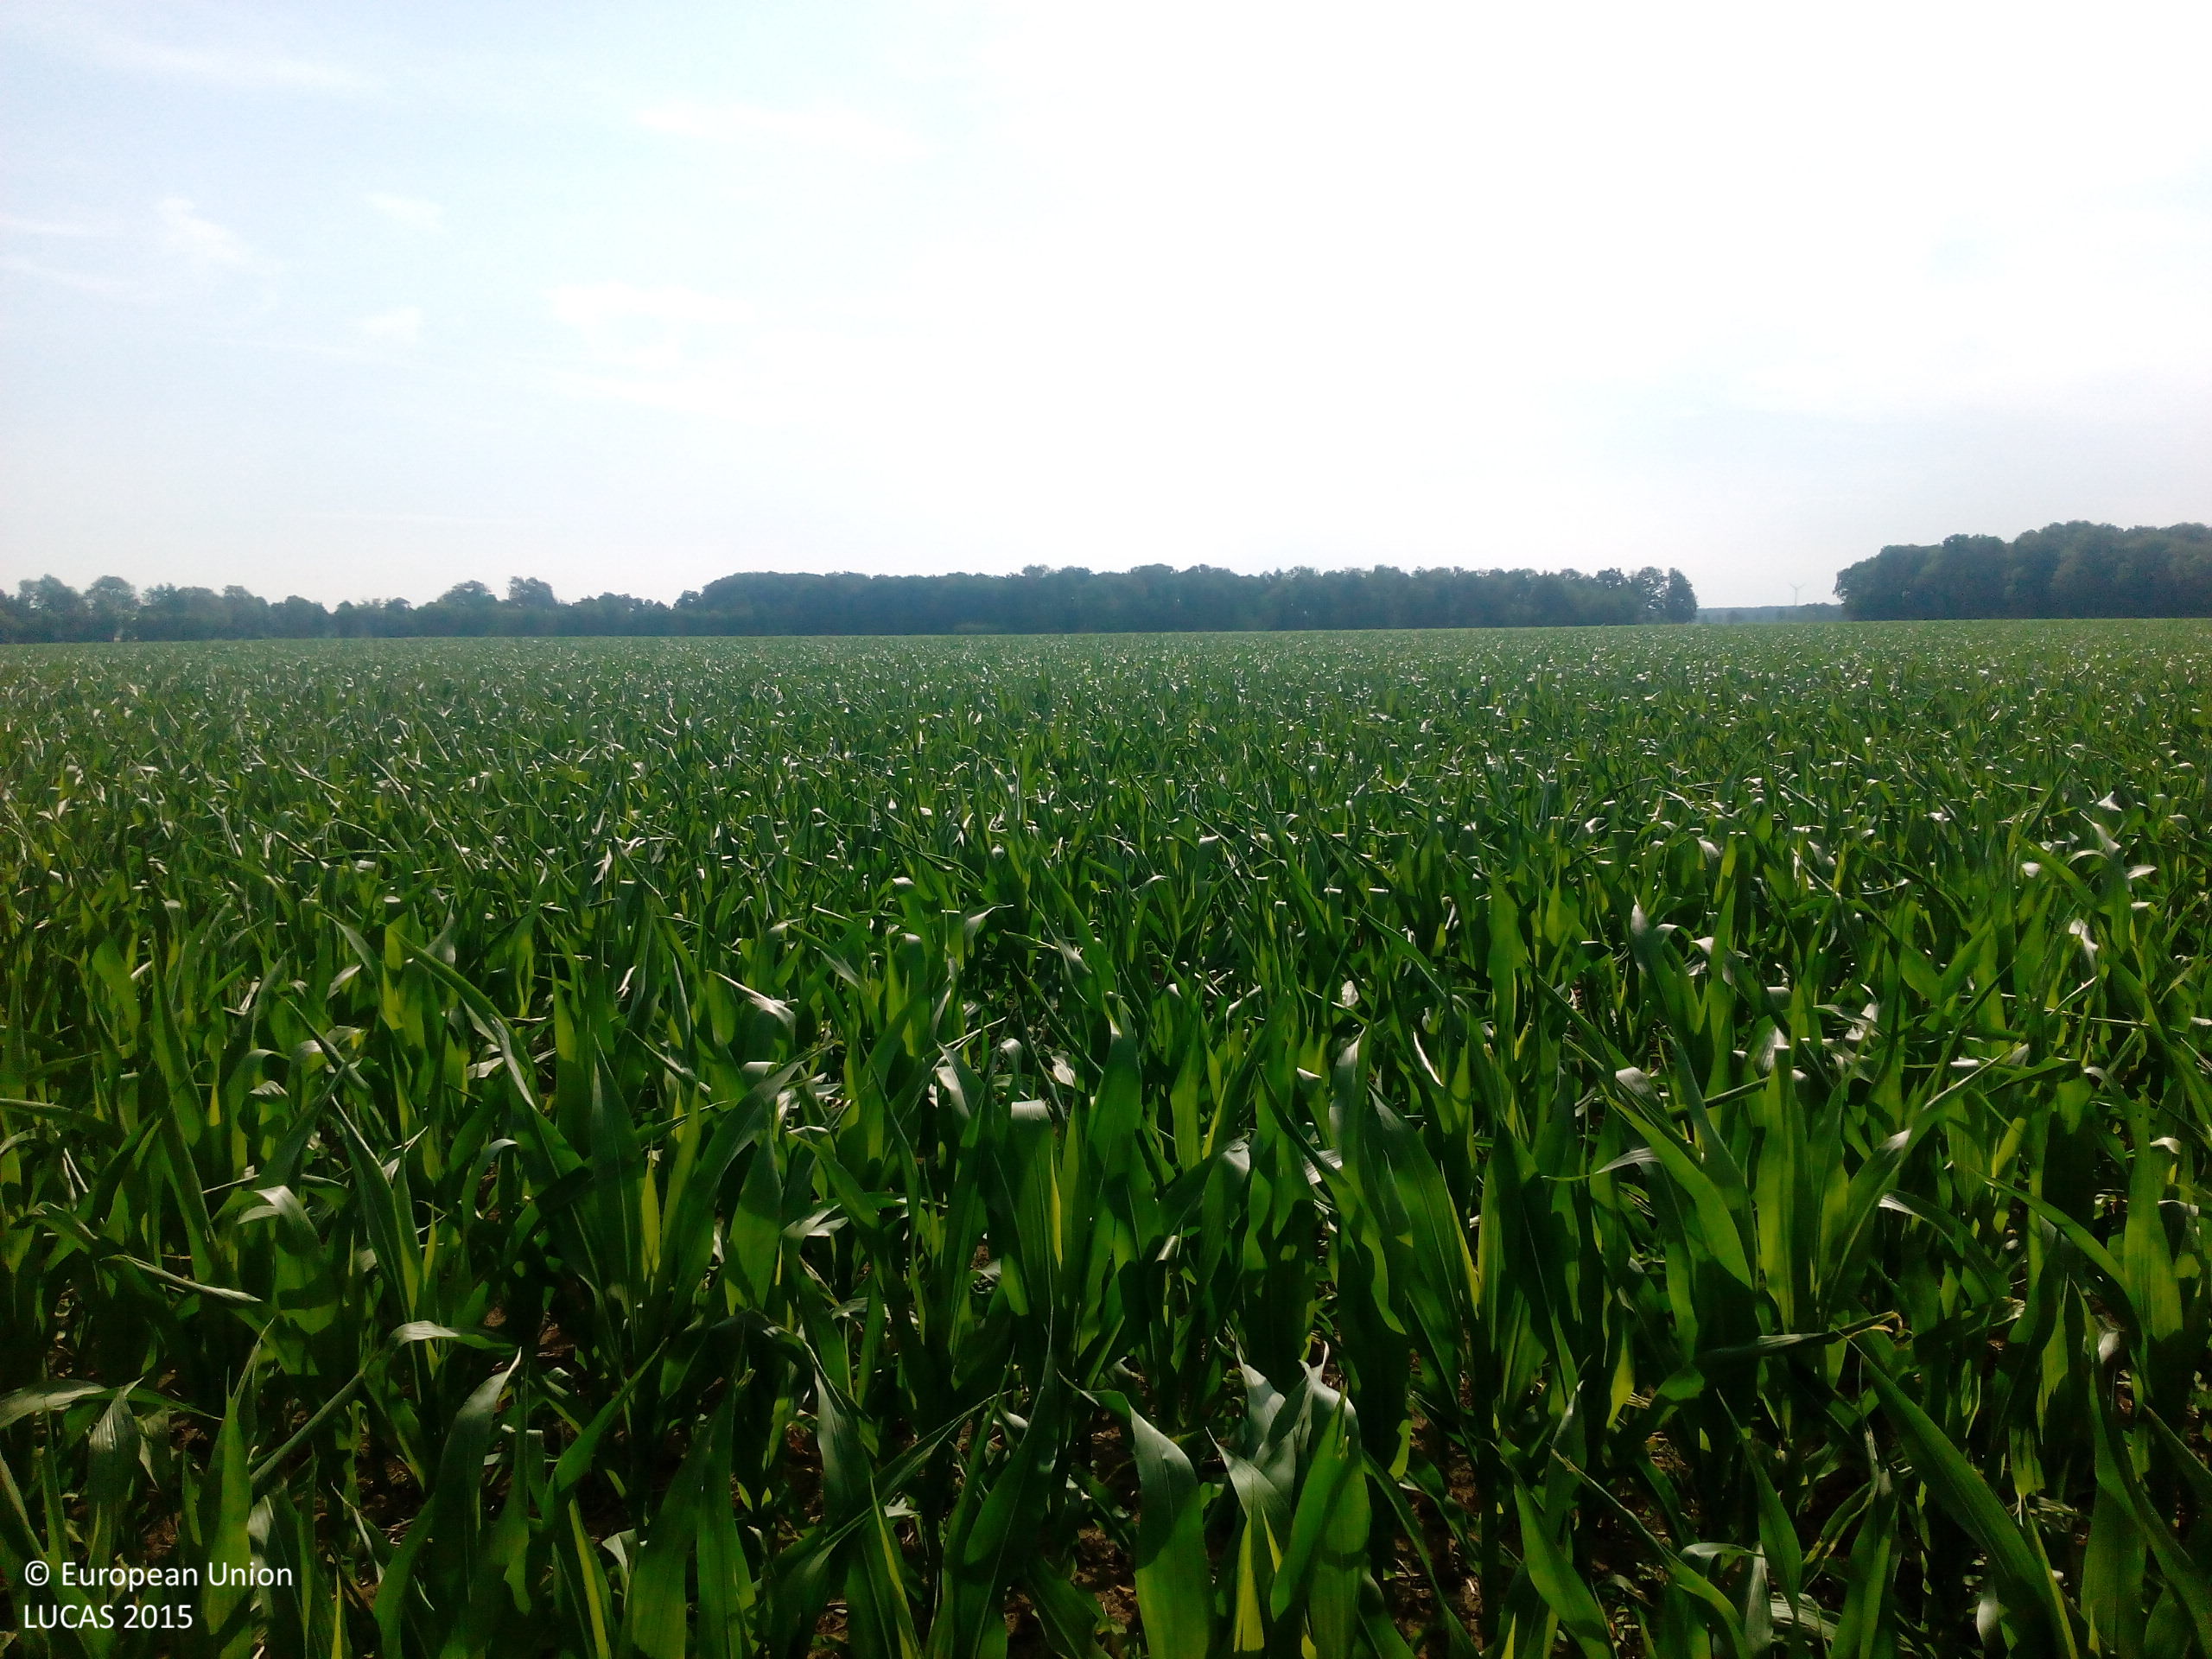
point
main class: Cropland
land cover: Maize
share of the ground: > 75 %
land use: Agriculture (excluding fallow land and kitchen gardens)
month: July
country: DE
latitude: 52.5338
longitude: 11.1348
